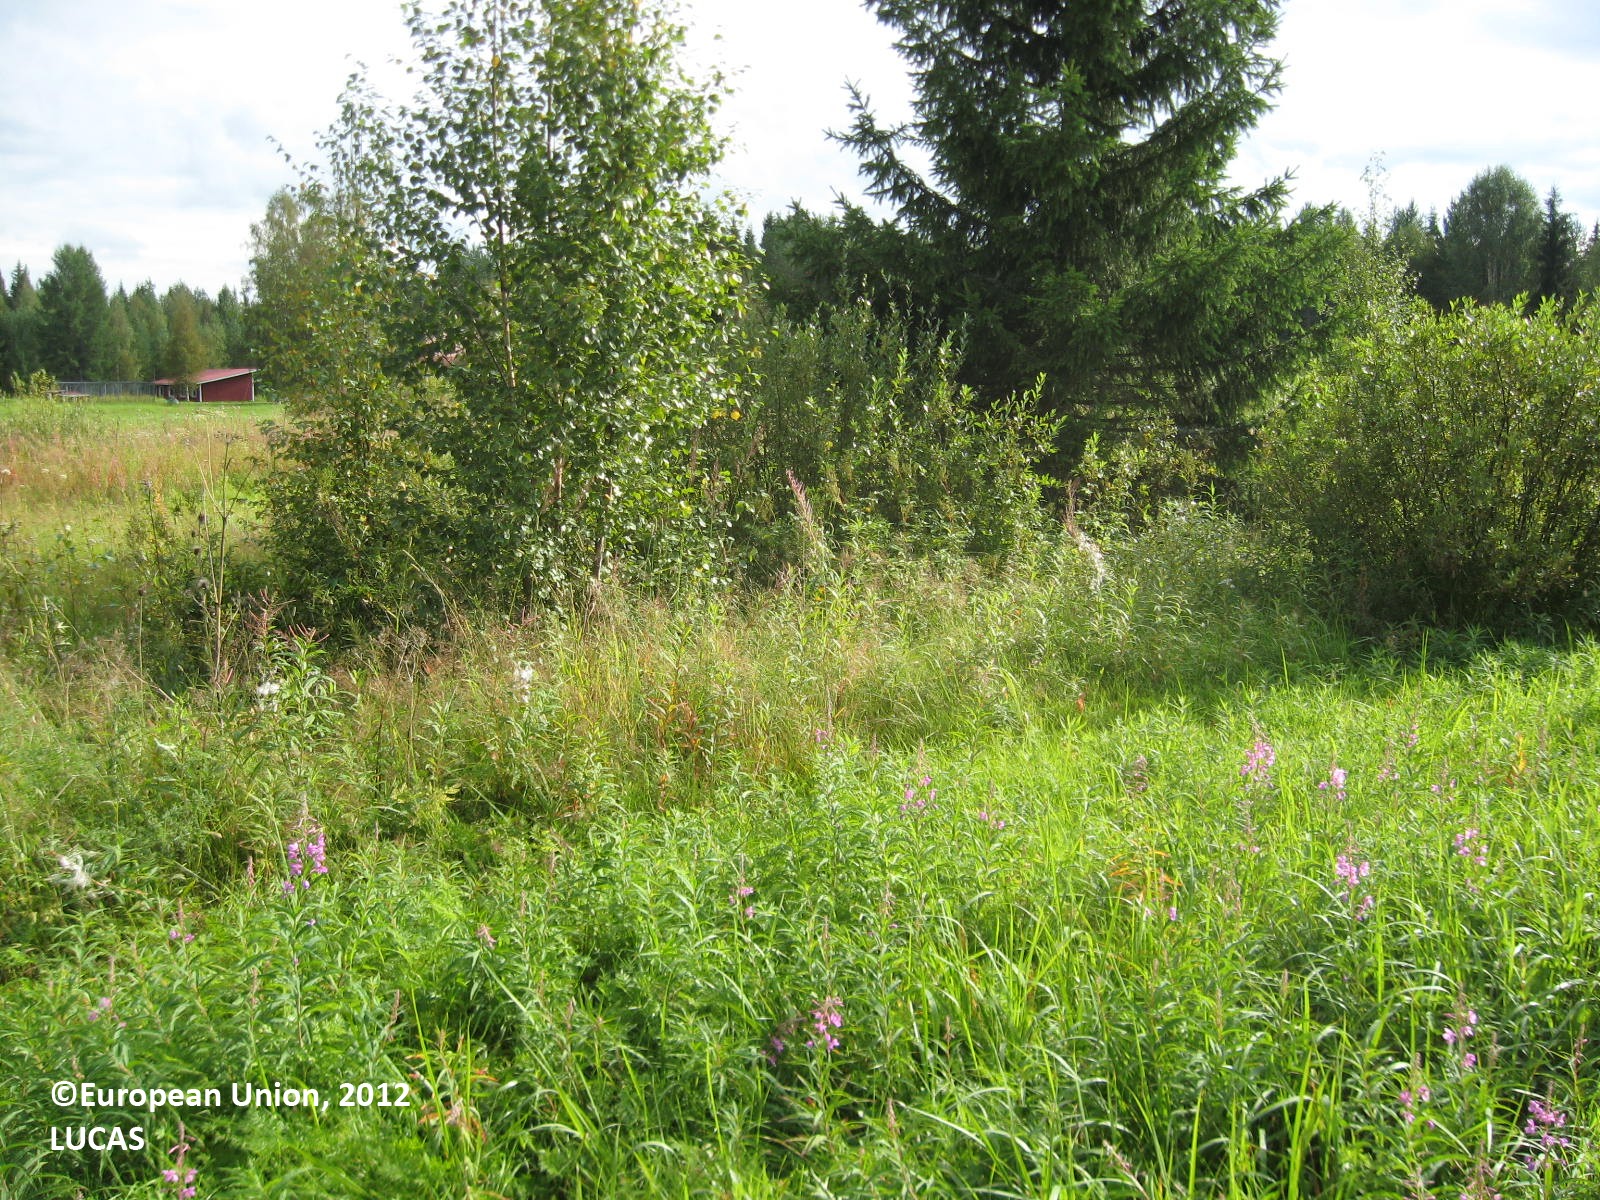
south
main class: Cropland
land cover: Temporary grasslands
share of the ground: > 75 %
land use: Agriculture (excluding fallow land and kitchen gardens)
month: August
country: FI
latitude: 63.3614
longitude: 30.0218
